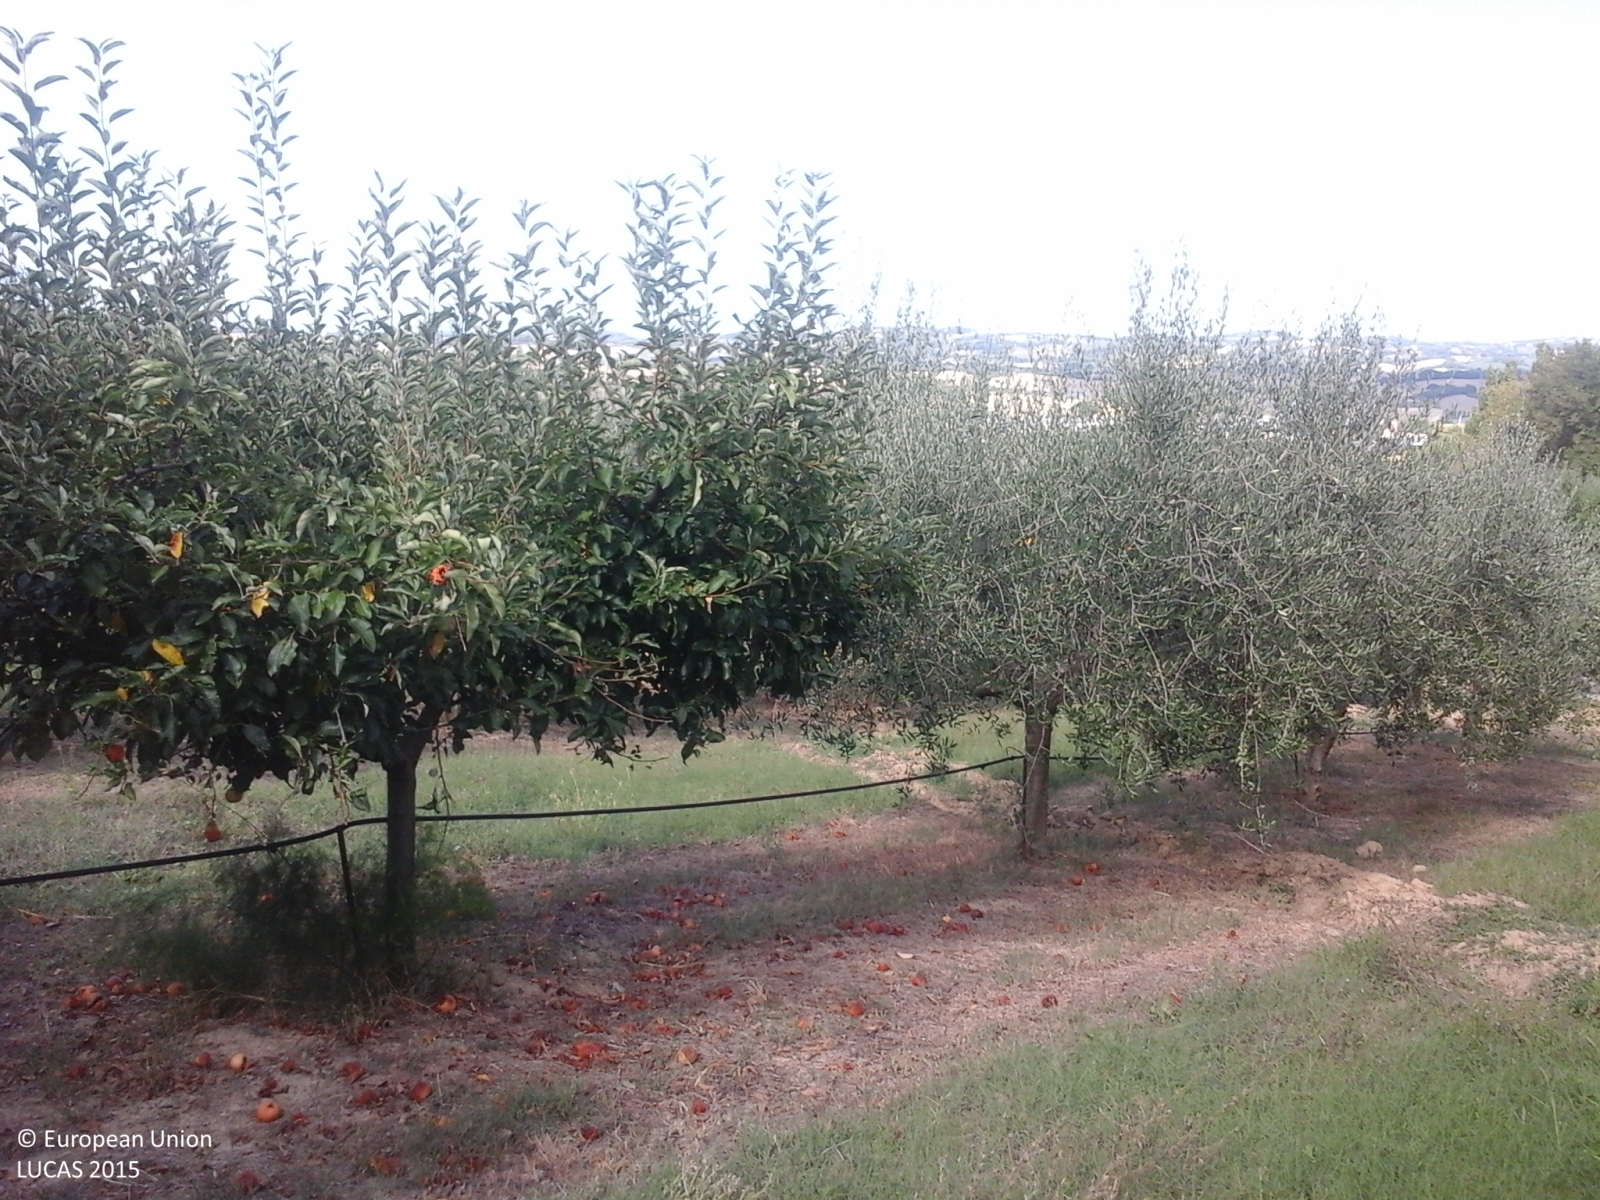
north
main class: Cropland
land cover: Olive groves
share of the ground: 50 - 75 %
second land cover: Grassland without tree/shrub cover
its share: > 75 %
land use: Agriculture (excluding fallow land and kitchen gardens)
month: September
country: IT
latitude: 43.8056
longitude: 12.8646
